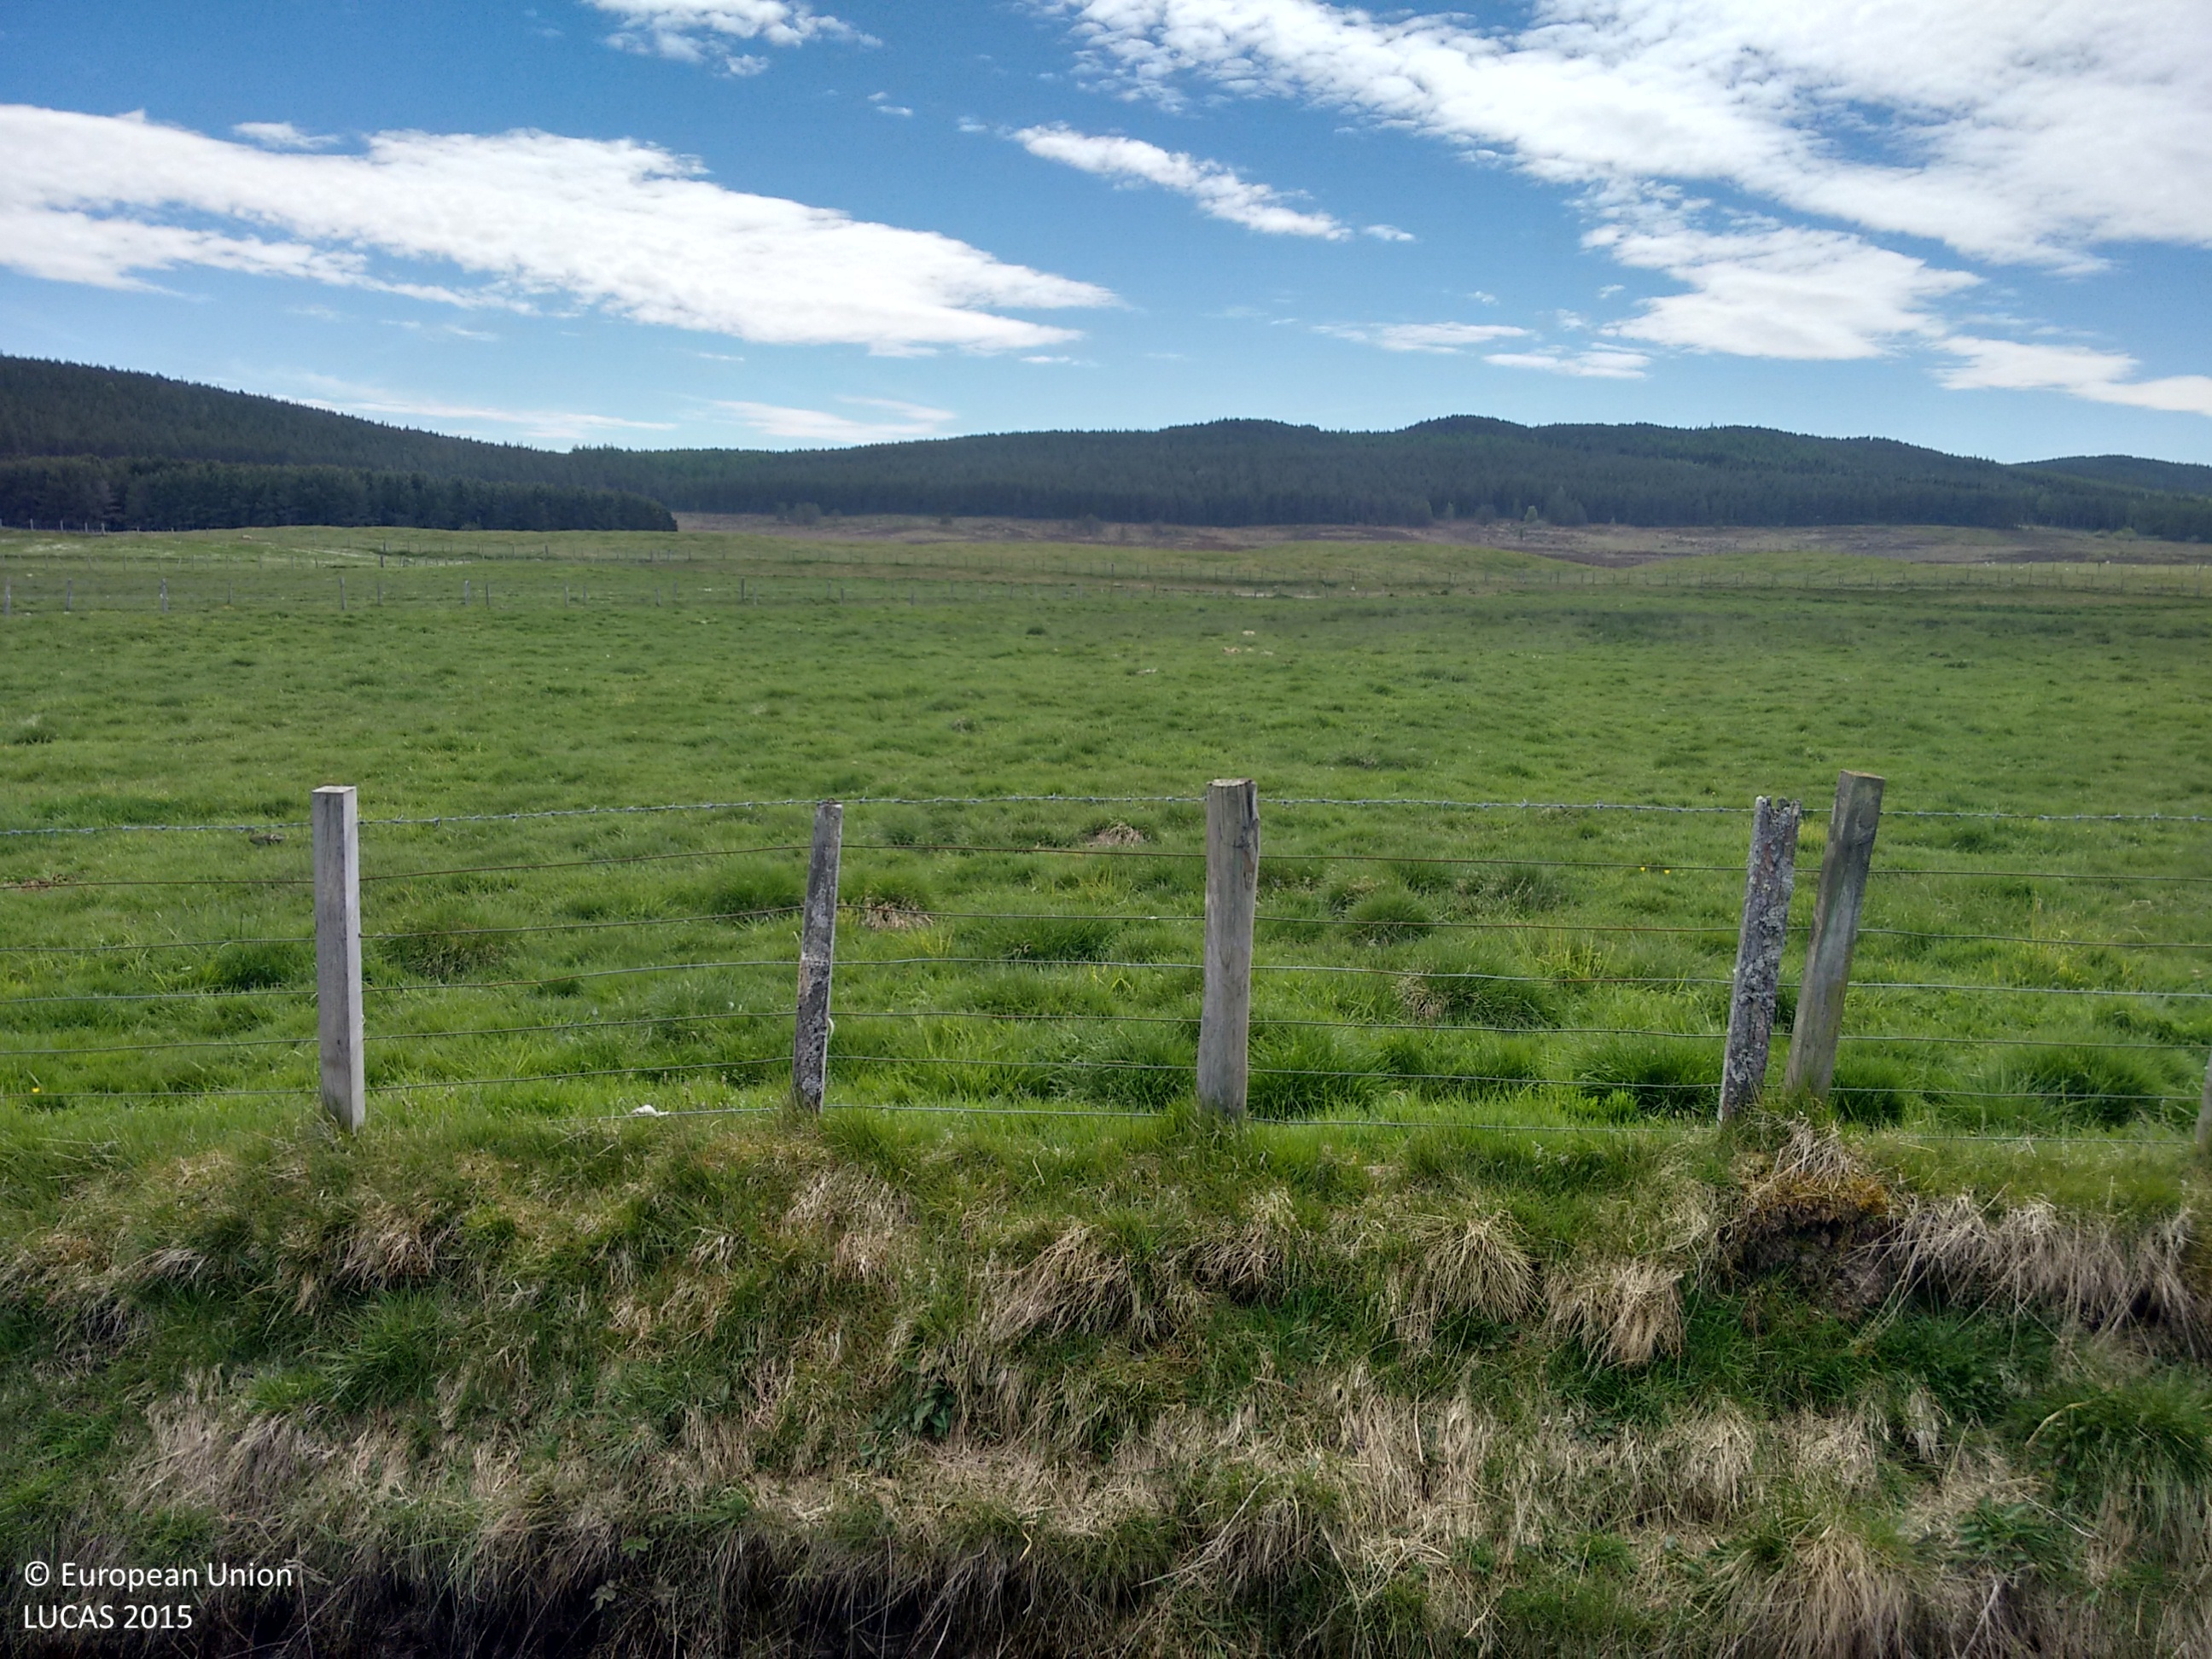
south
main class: Grassland
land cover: Grassland without tree/shrub cover
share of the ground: > 75 %
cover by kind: herbaceous plants 100 %
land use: Agriculture (excluding fallow land and kitchen gardens)
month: June
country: GB
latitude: 57.2906
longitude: -3.7314
